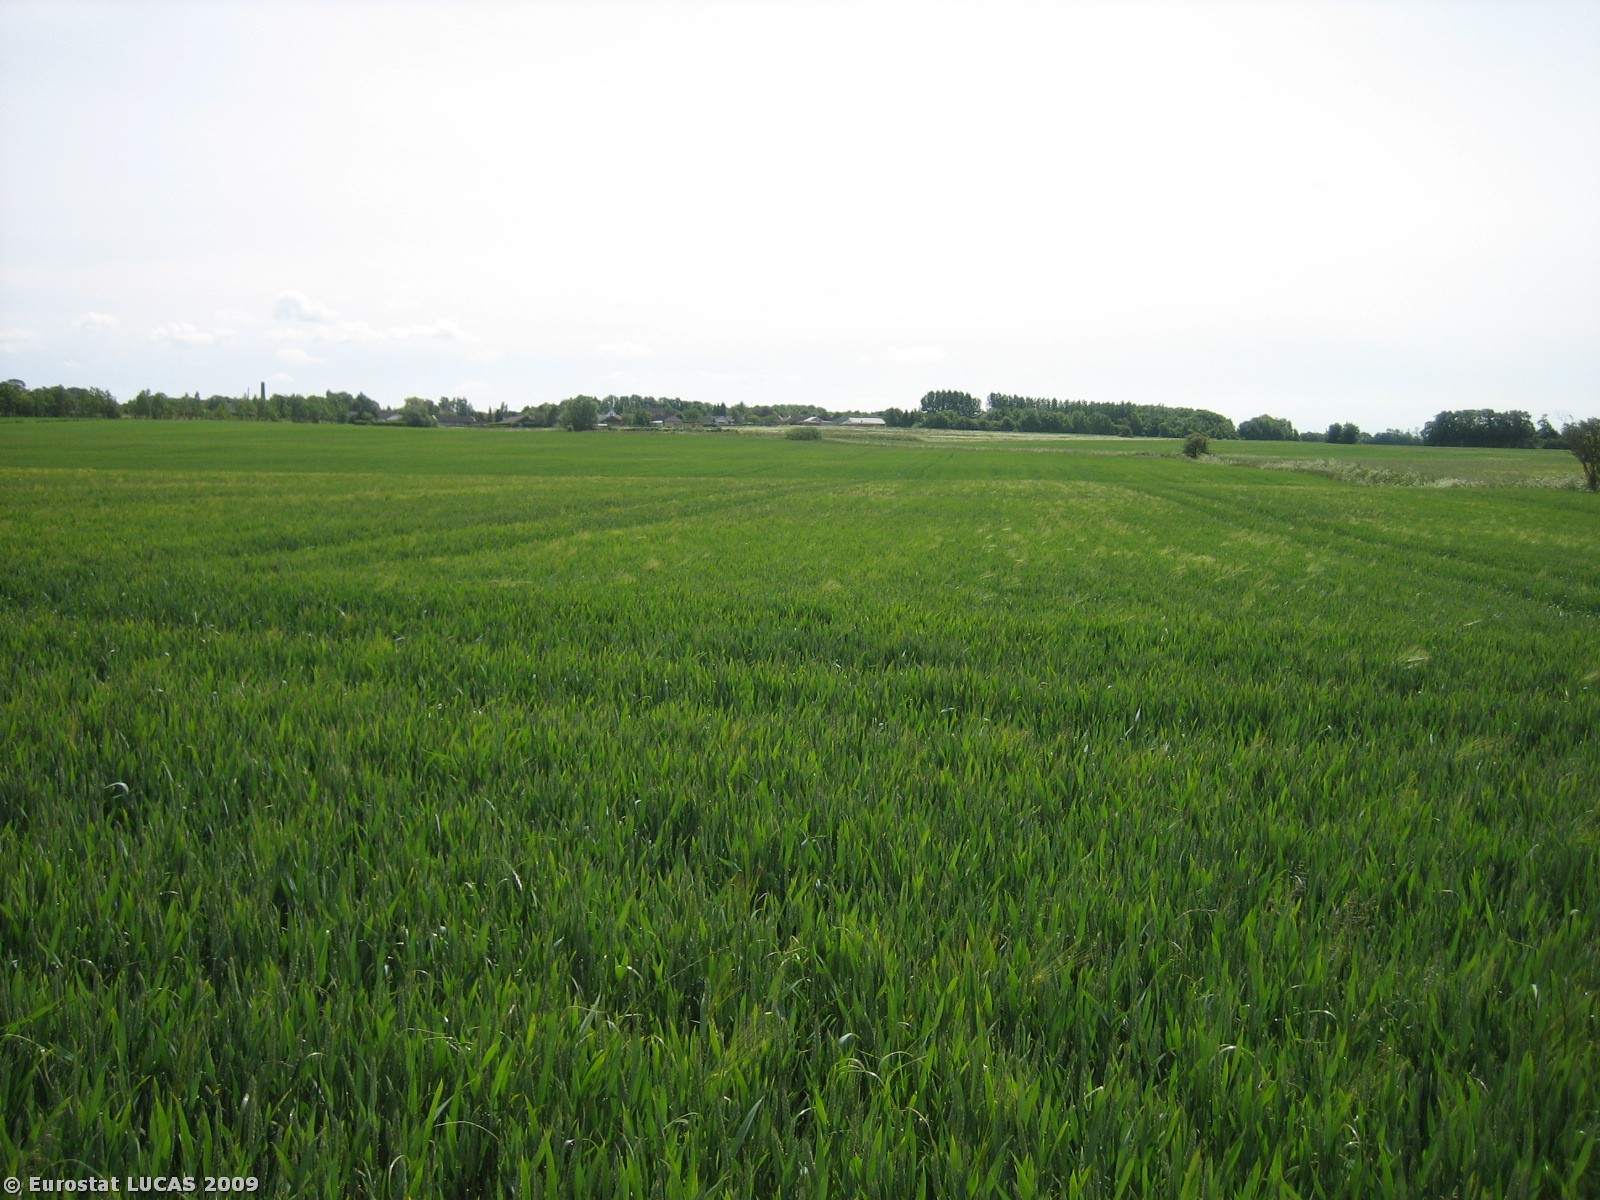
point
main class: Cropland
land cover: Common wheat
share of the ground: > 75 %
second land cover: Barley
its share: < 10 %
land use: Agriculture (excluding fallow land and kitchen gardens)
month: June
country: DK
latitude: 56.2954
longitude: 10.2098
